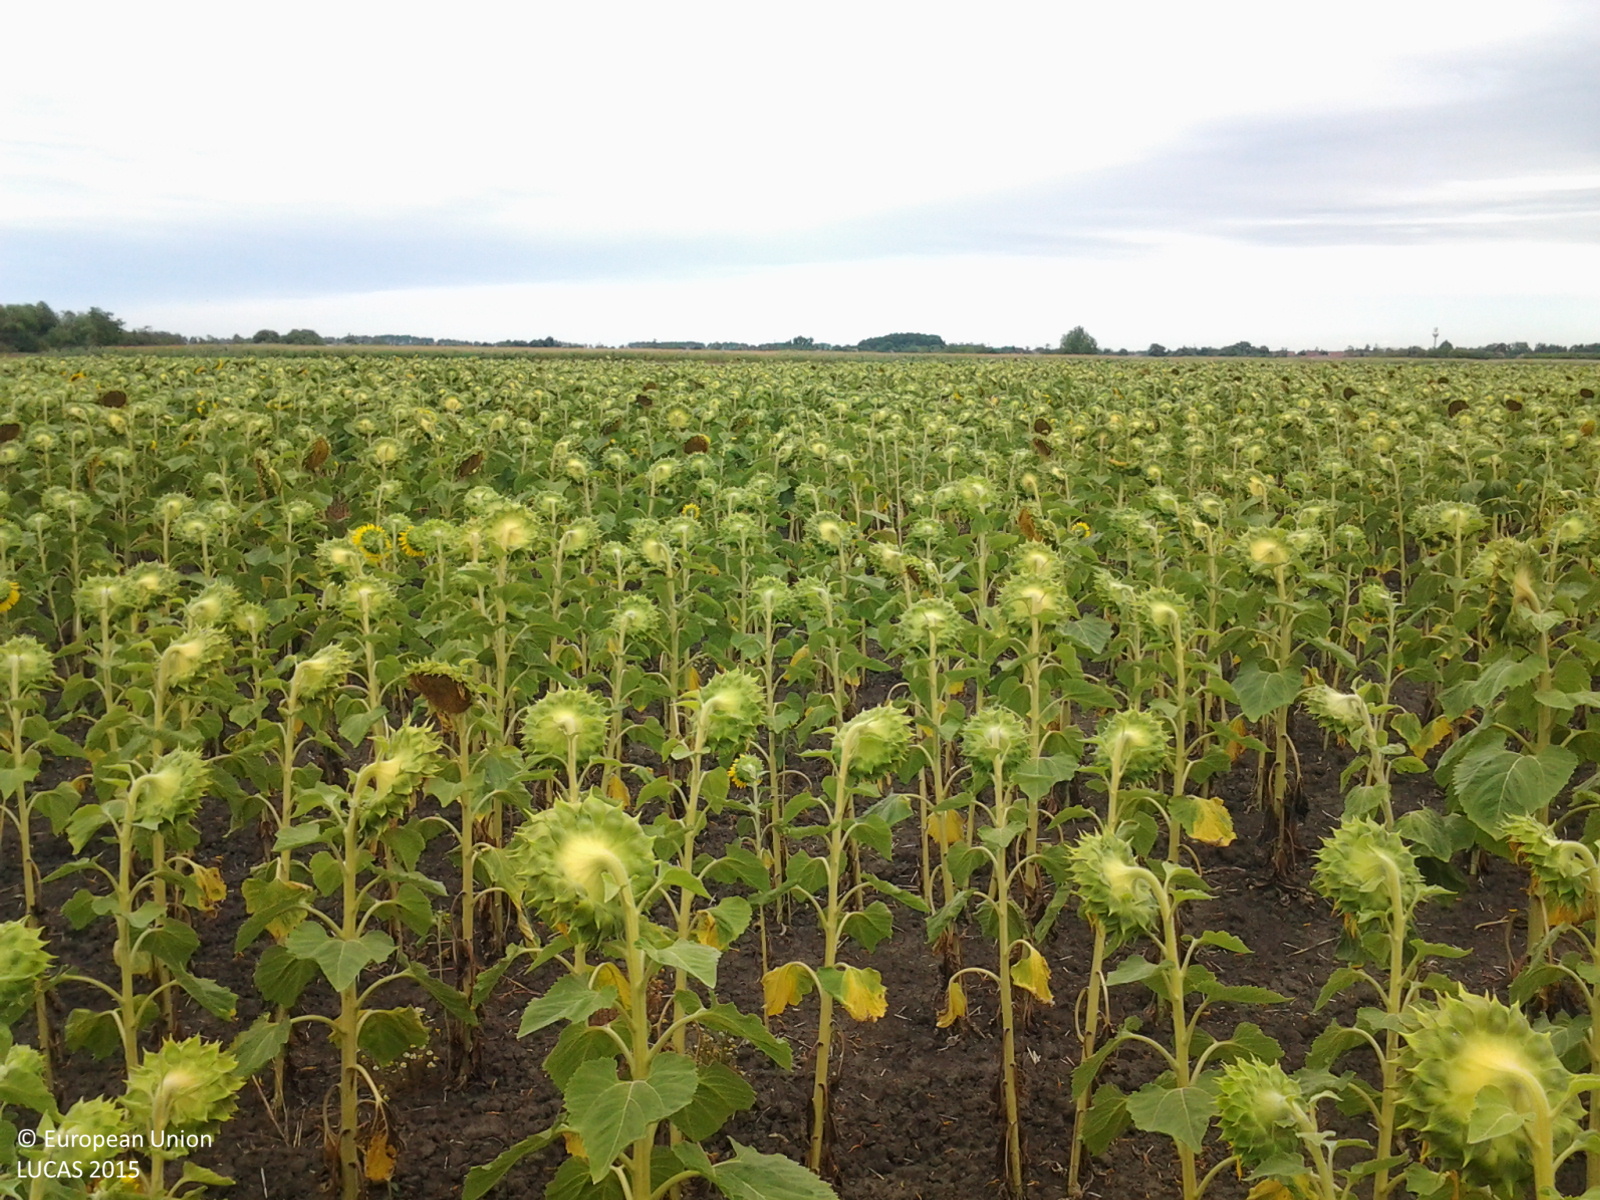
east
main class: Cropland
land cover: Sunflower
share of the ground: > 75 %
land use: Agriculture (excluding fallow land and kitchen gardens)
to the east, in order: Sunflower; Barley; Maize
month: July
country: HU
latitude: 47.1363
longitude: 20.5380
